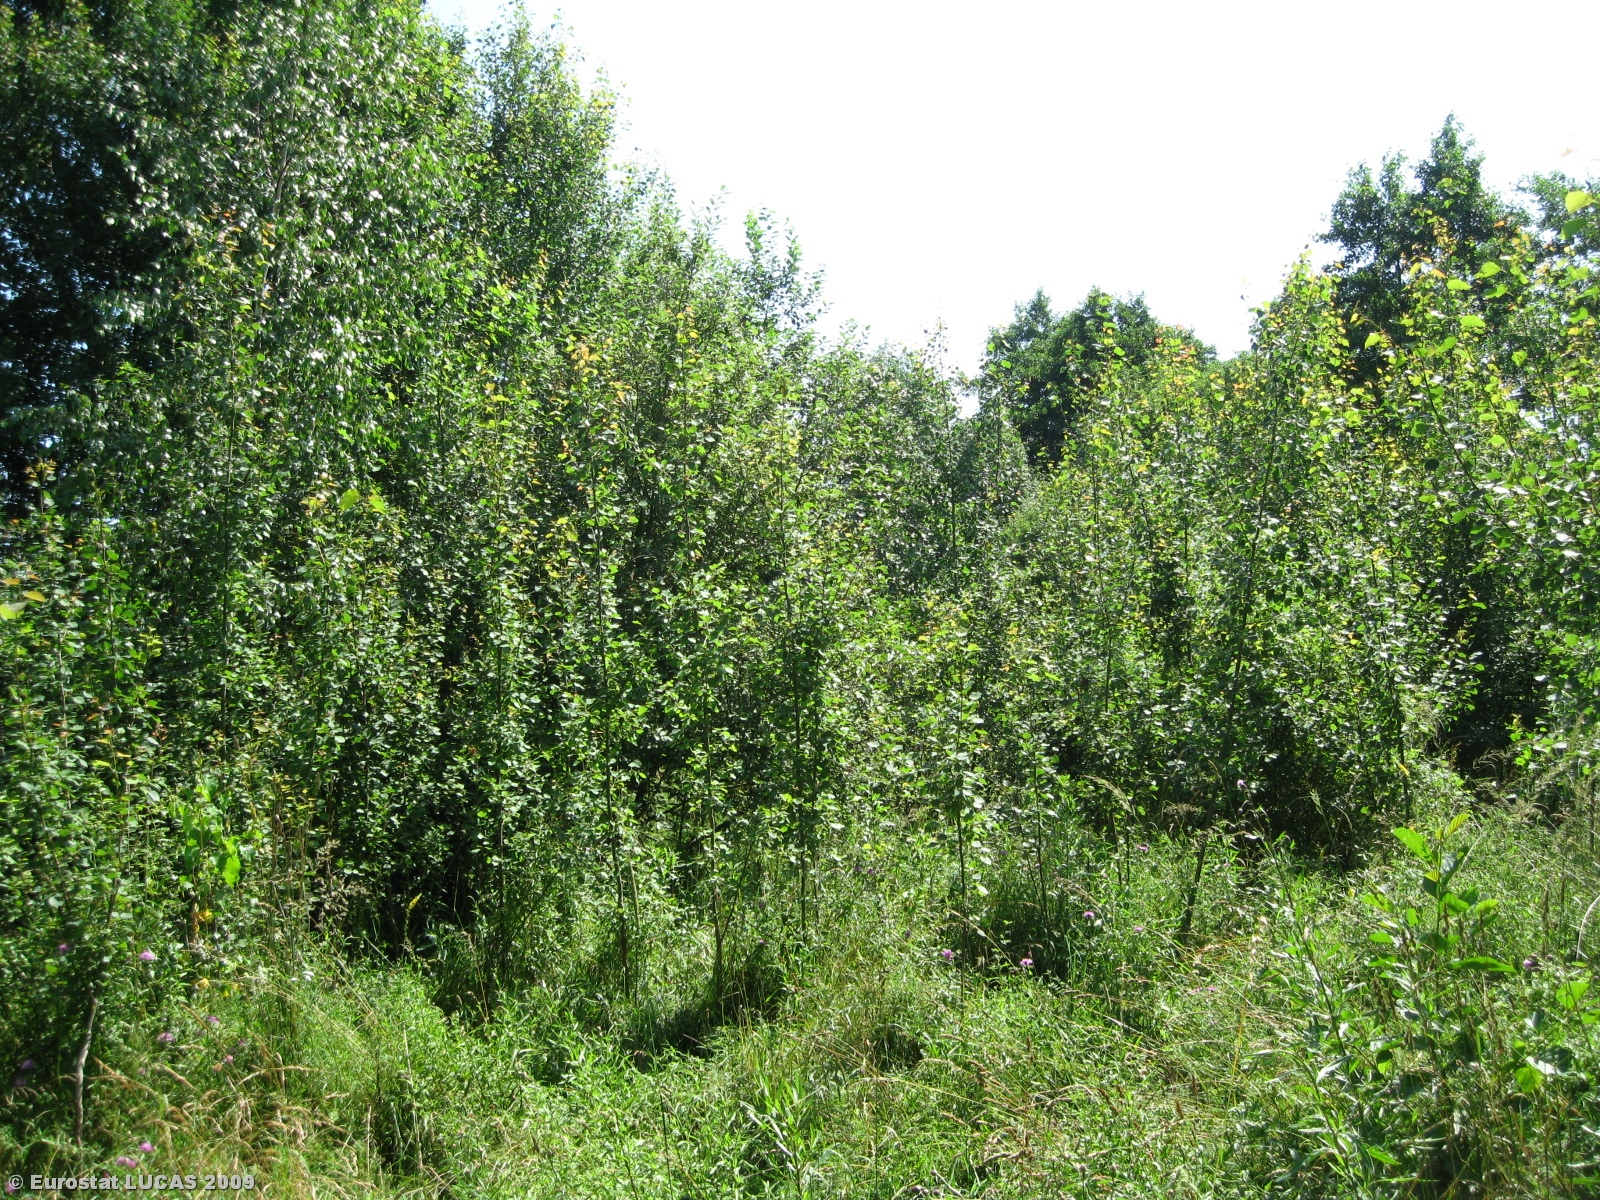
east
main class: Woodland
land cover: Broadleaved woodland
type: non-riverine alder, birch or aspen forest
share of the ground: > 75 %
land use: Forestry
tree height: > 5 m
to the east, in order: Broadleaved woodland; Grassland with sparse tree/shrub cover; Broadleaved woodland; Grassland with sparse tree/shrub cover; Paved roads, cycling and walking lanes; Grassland without tree/shrub cover
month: July
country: LT
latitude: 54.4771
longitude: 23.3984
